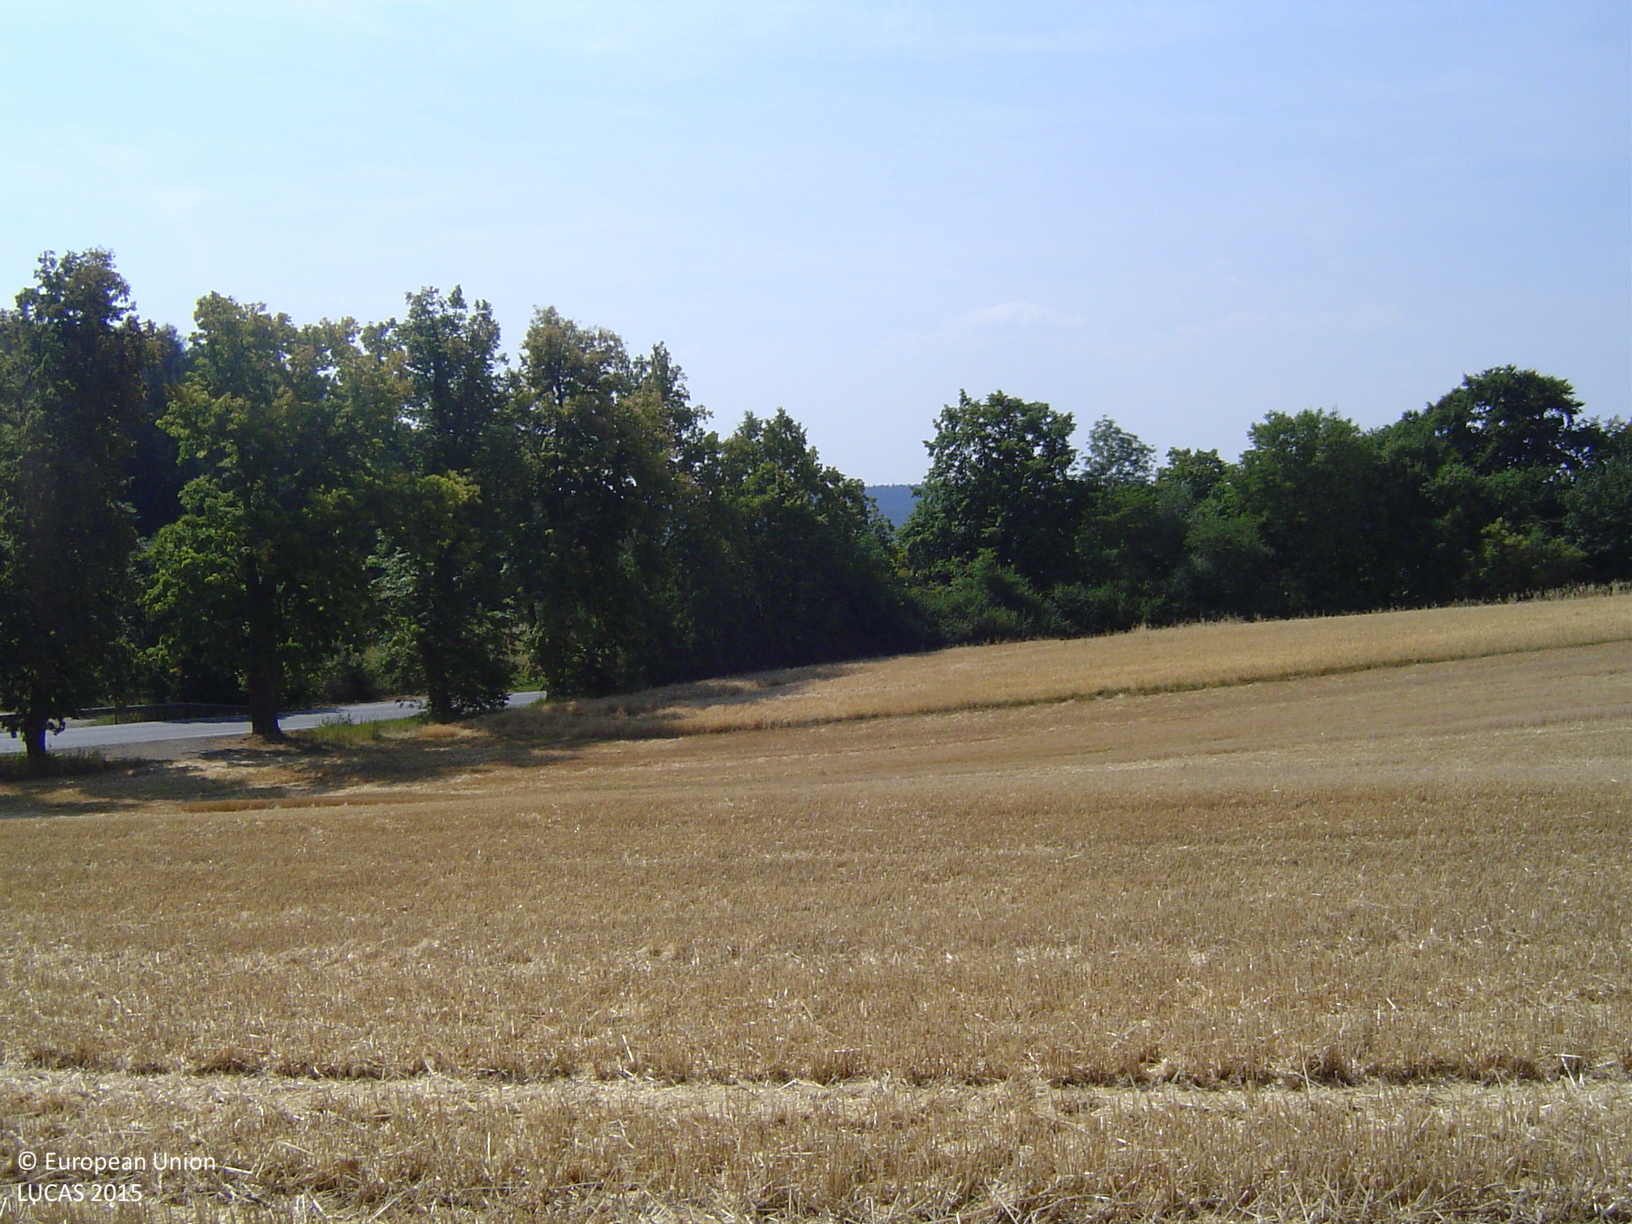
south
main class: Cropland
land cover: Barley
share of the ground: > 75 %
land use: Agriculture (excluding fallow land and kitchen gardens)
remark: Harvested field
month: August
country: CZ
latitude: 50.1921
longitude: 13.8247
